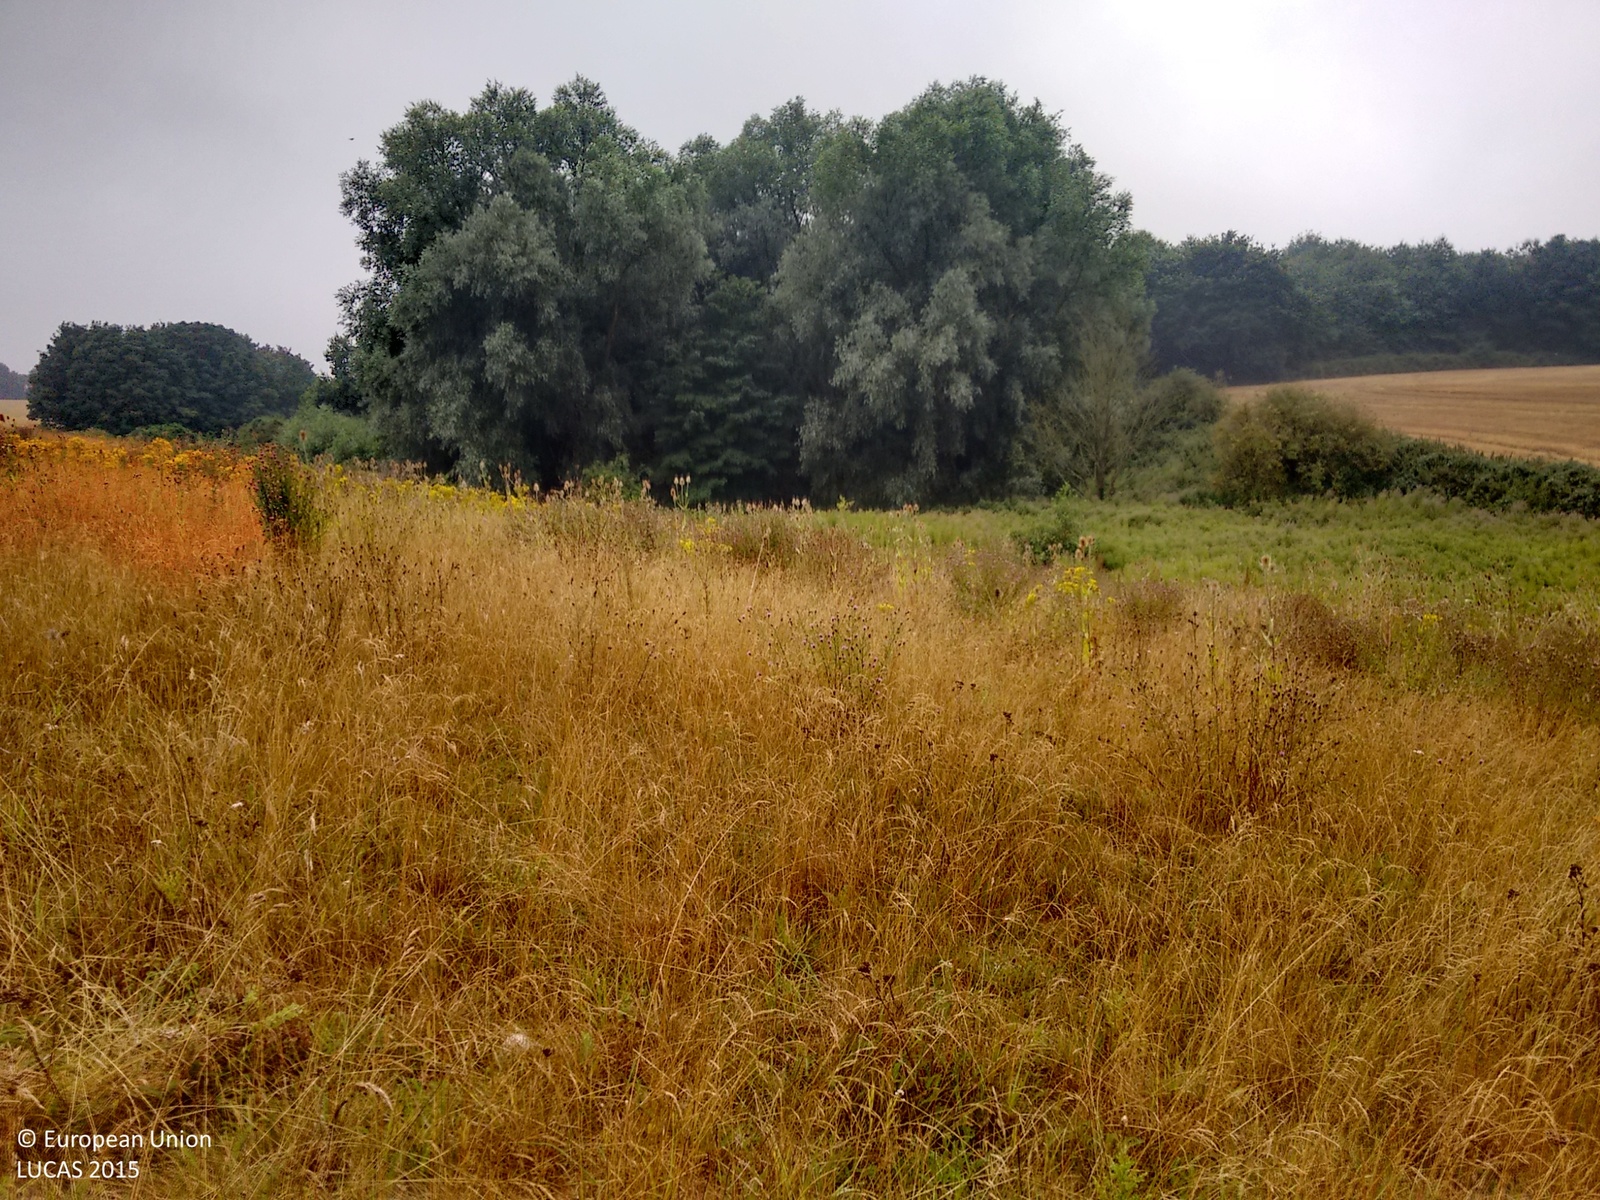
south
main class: Grassland
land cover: Grassland without tree/shrub cover
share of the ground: > 75 %
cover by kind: herbaceous plants 100 %
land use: Agriculture (excluding fallow land and kitchen gardens)
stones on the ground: 10 - 25 %
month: August
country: GB
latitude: 51.9669
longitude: 1.0549
